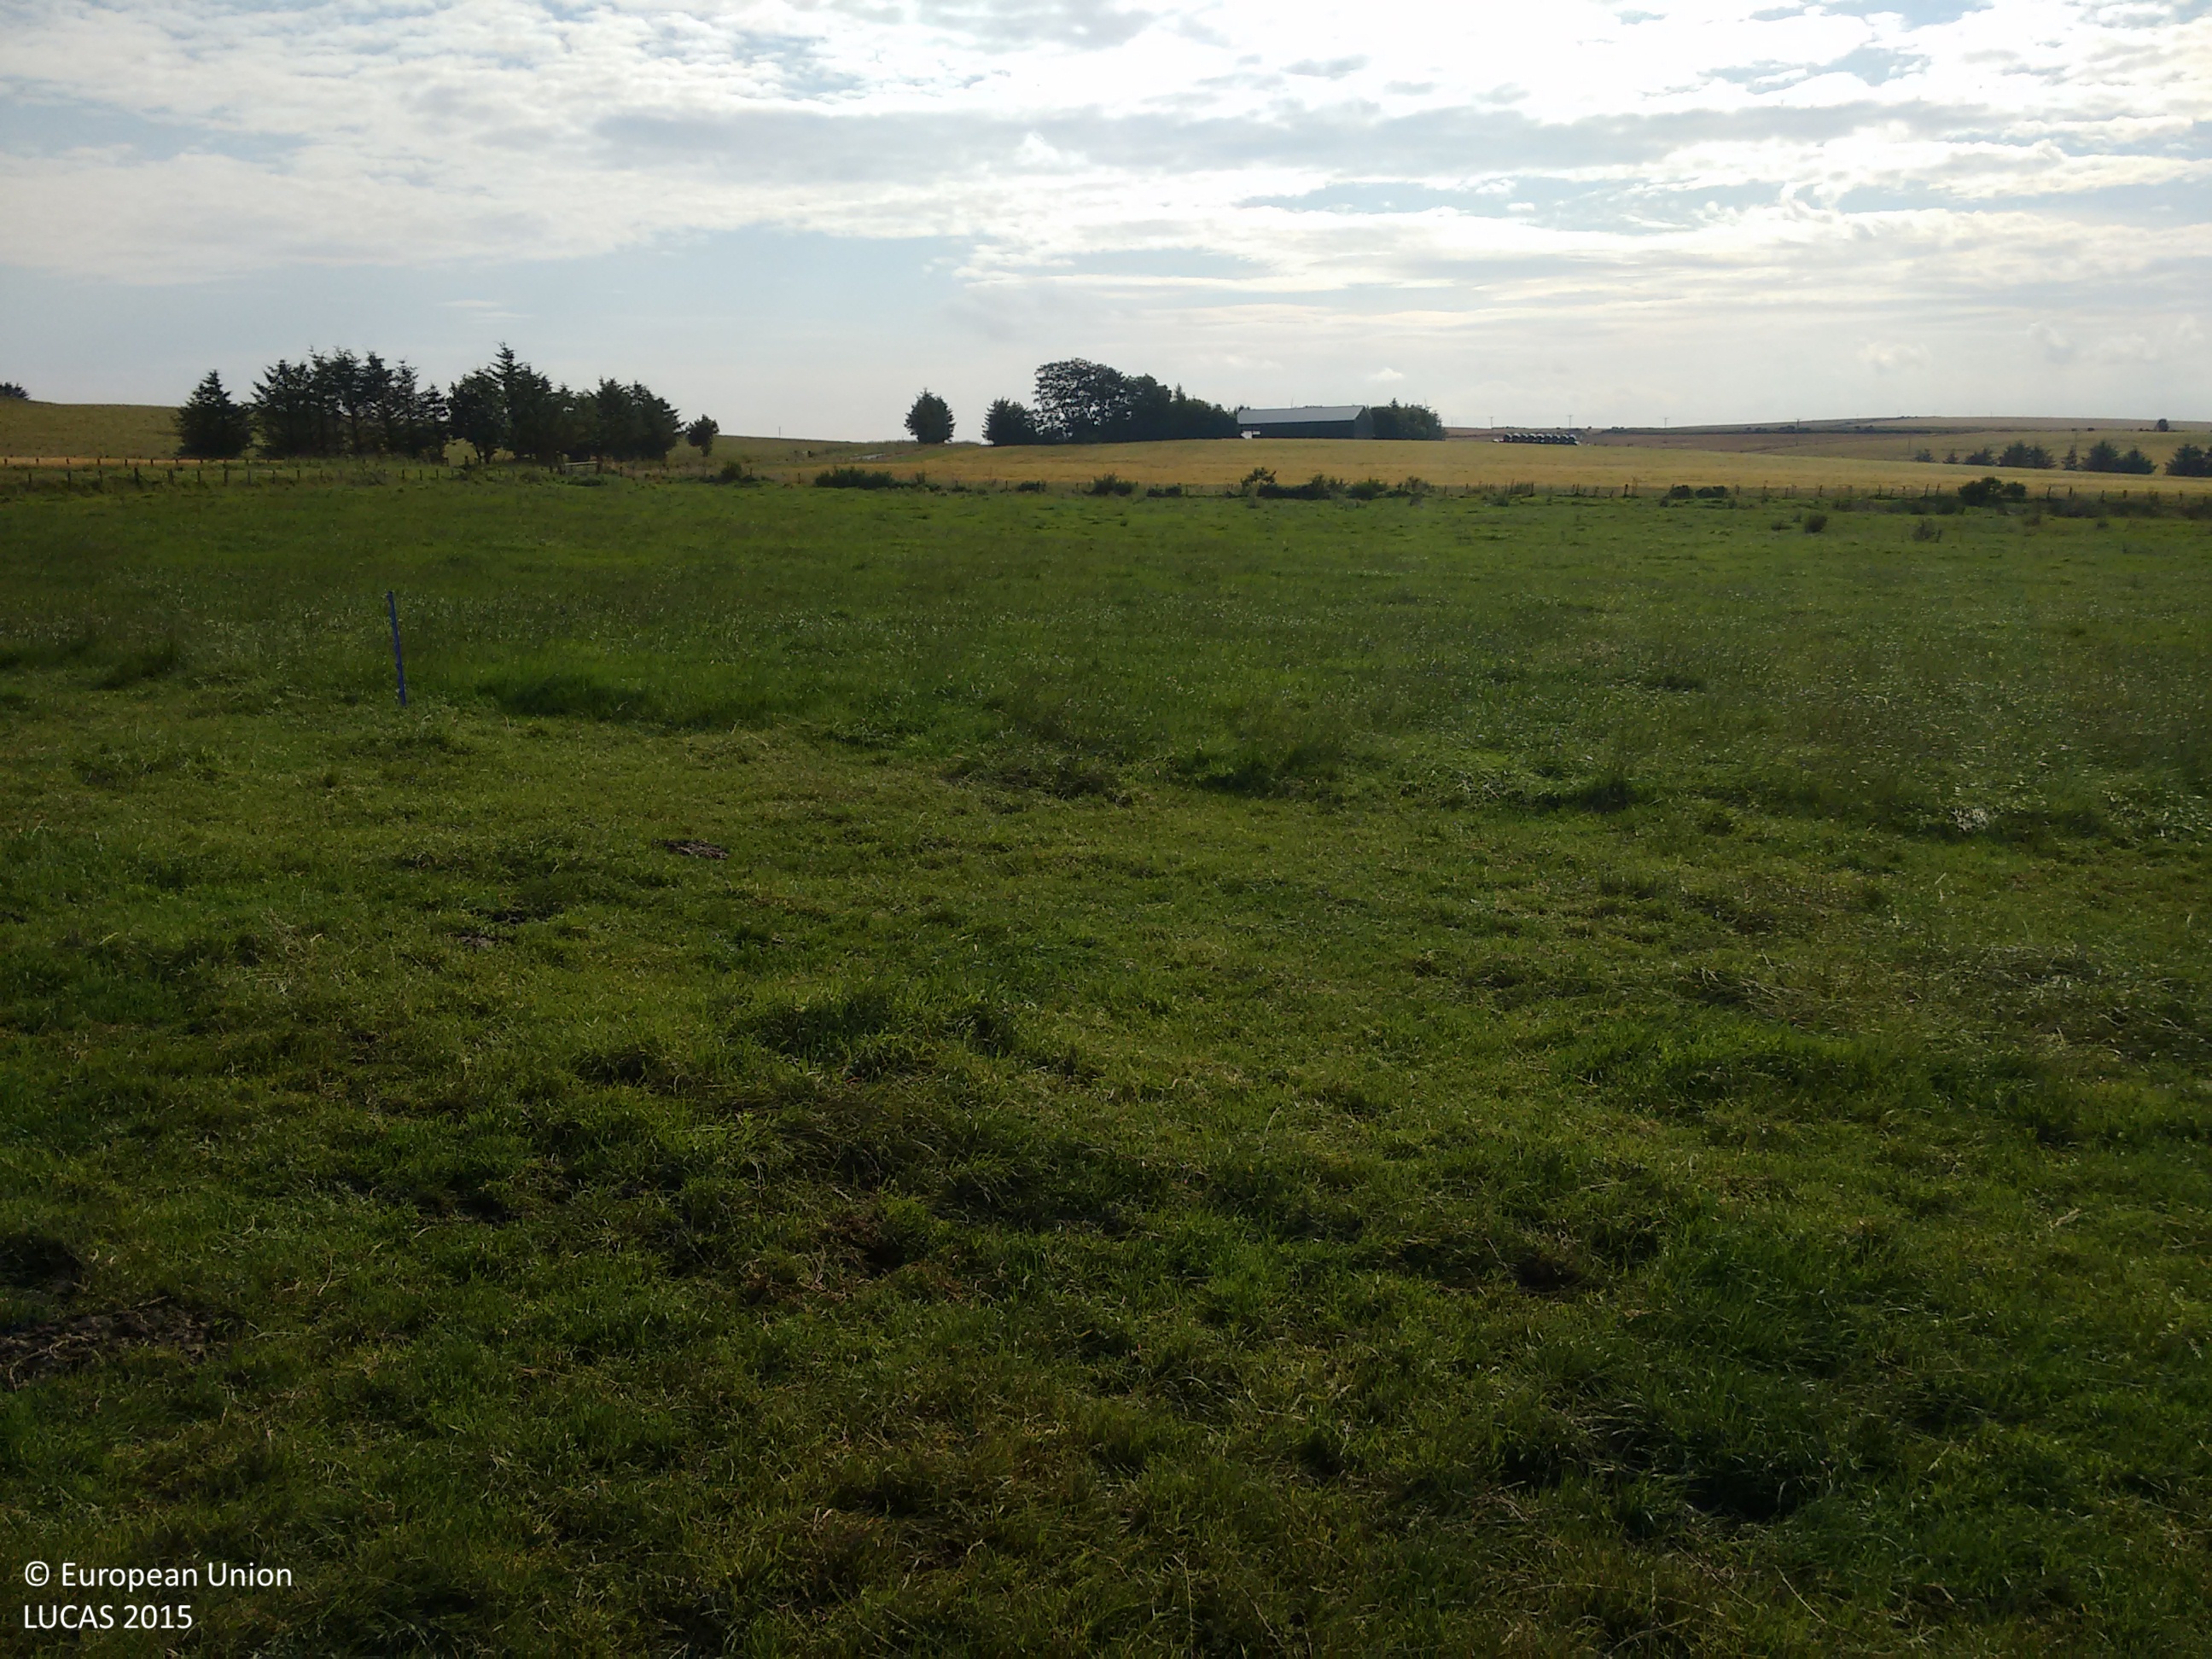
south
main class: Grassland
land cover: Grassland without tree/shrub cover
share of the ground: > 75 %
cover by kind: herbaceous plants 100 %
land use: Agriculture (excluding fallow land and kitchen gardens)
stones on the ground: < 10 %
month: August
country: GB
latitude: 57.4961
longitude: -2.2119
